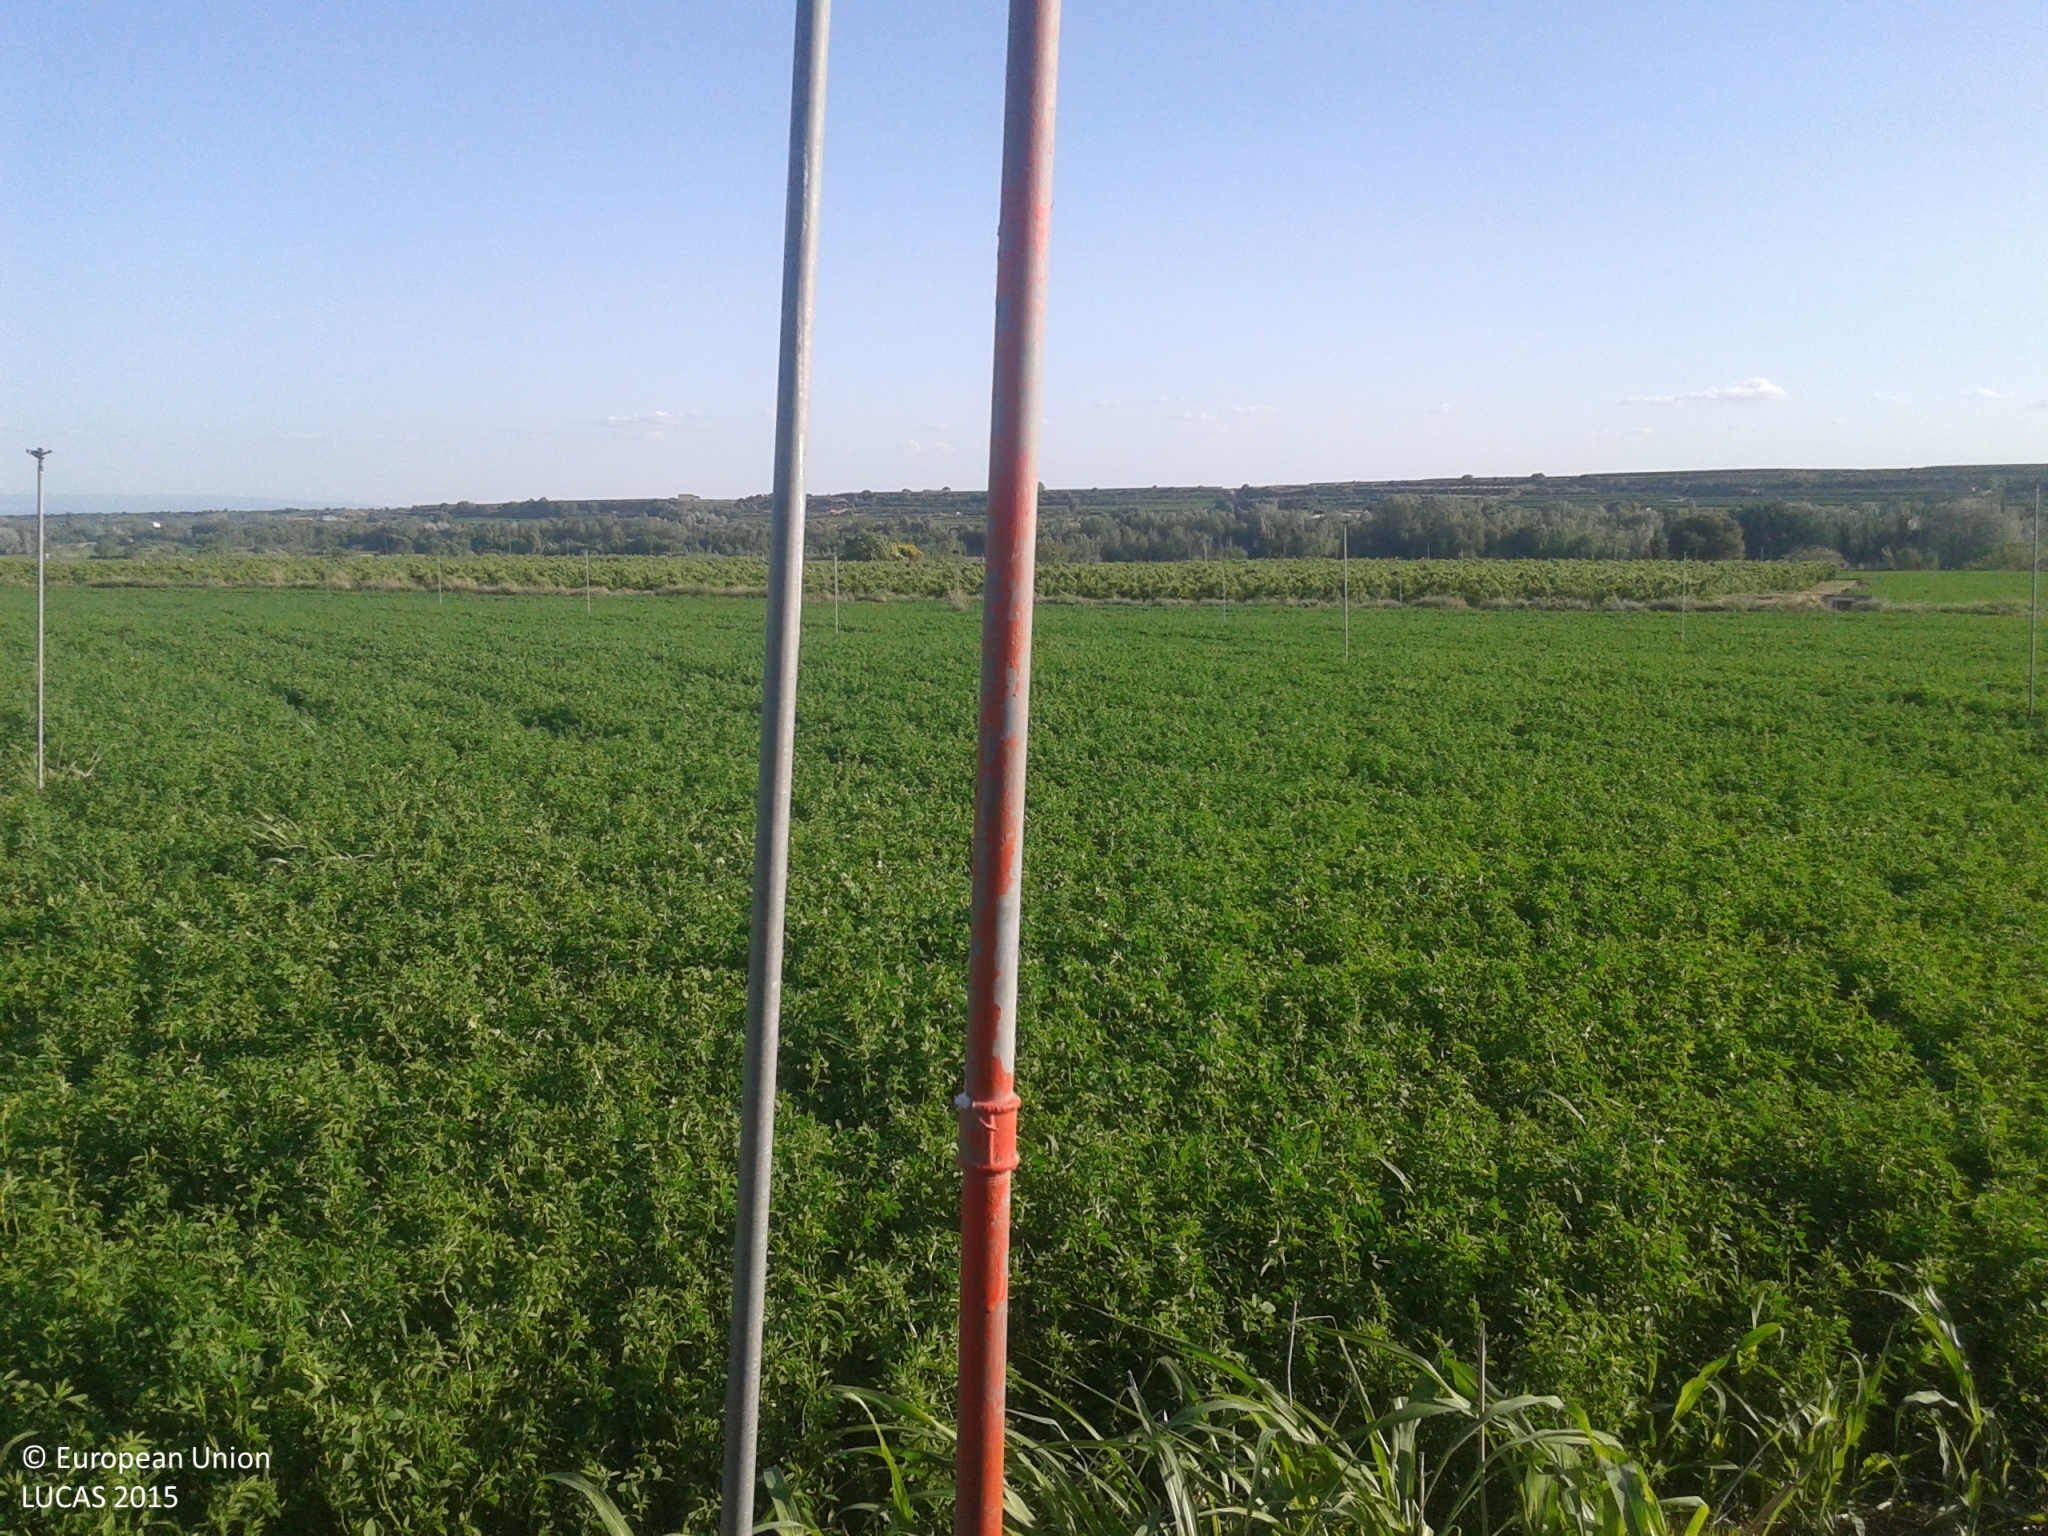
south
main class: Cropland
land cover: Pear fruit
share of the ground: 25 - 50 %
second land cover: Grassland without tree/shrub cover
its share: > 75 %
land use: Agriculture (excluding fallow land and kitchen gardens)
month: May
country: ES
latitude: 41.7654
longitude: 0.6403
